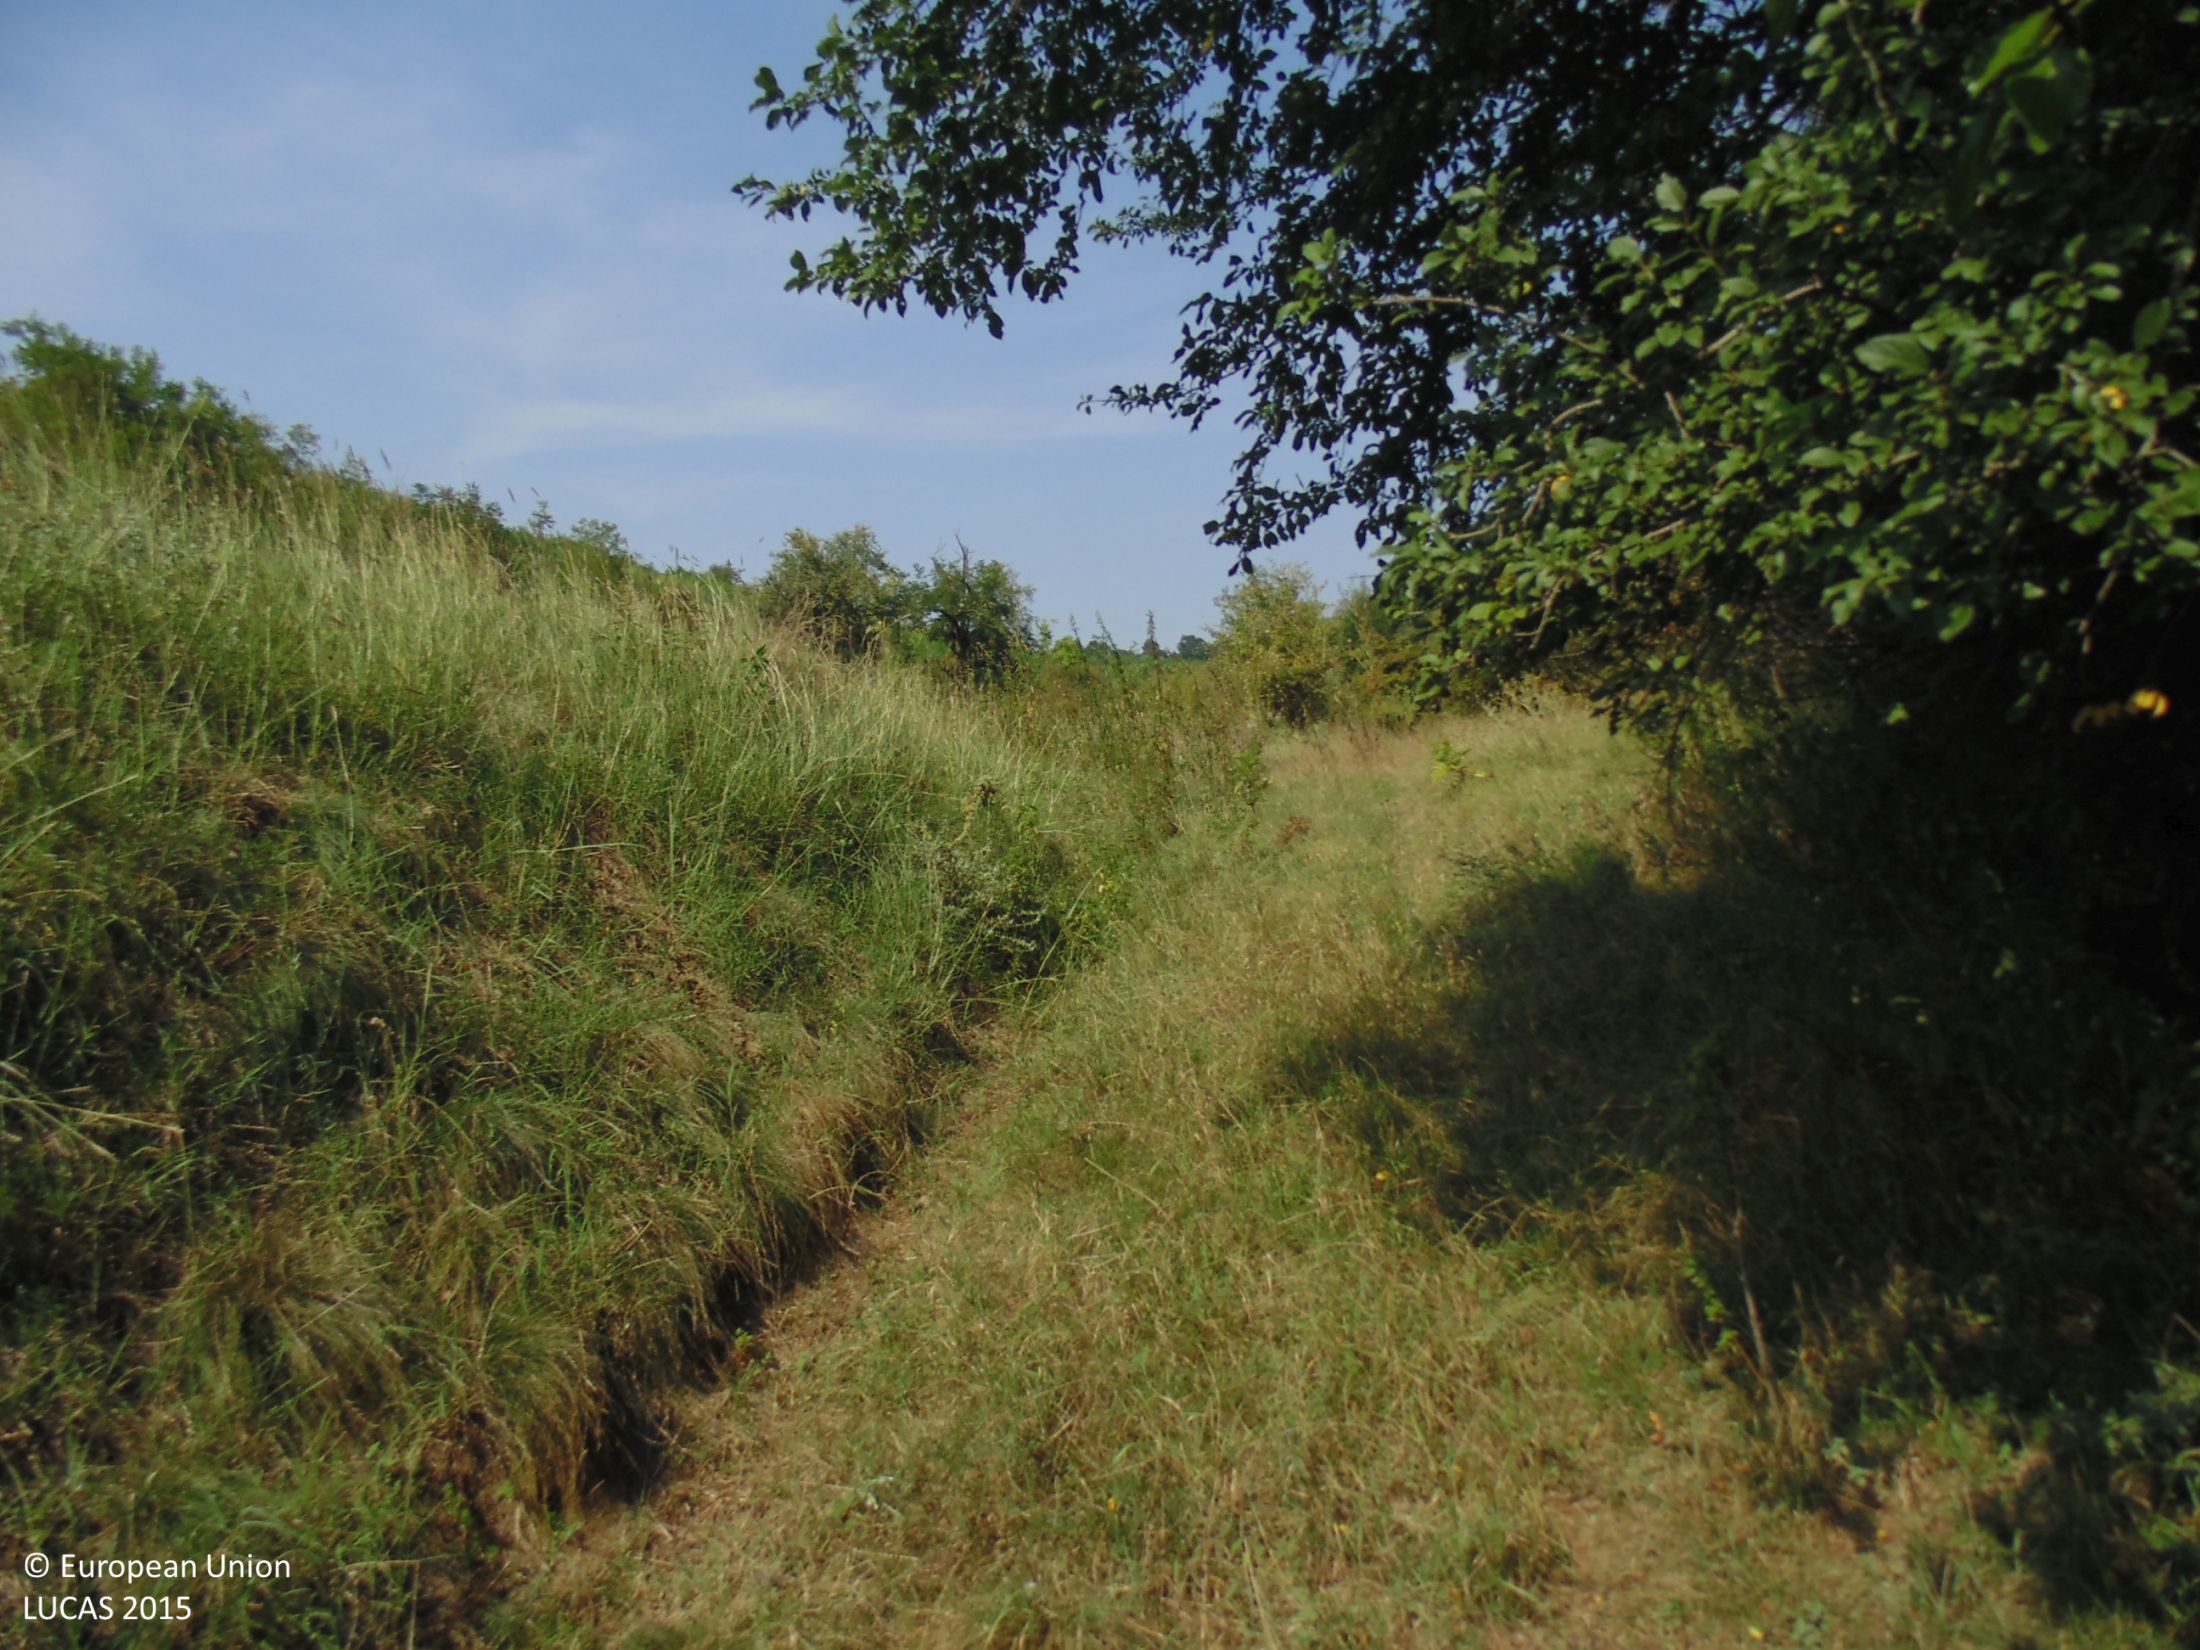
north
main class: Grassland
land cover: Grassland without tree/shrub cover
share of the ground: > 75 %
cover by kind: herbaceous plants 100 %
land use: Agriculture (excluding fallow land and kitchen gardens)
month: August
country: BG
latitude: 43.9496
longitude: 27.3141
